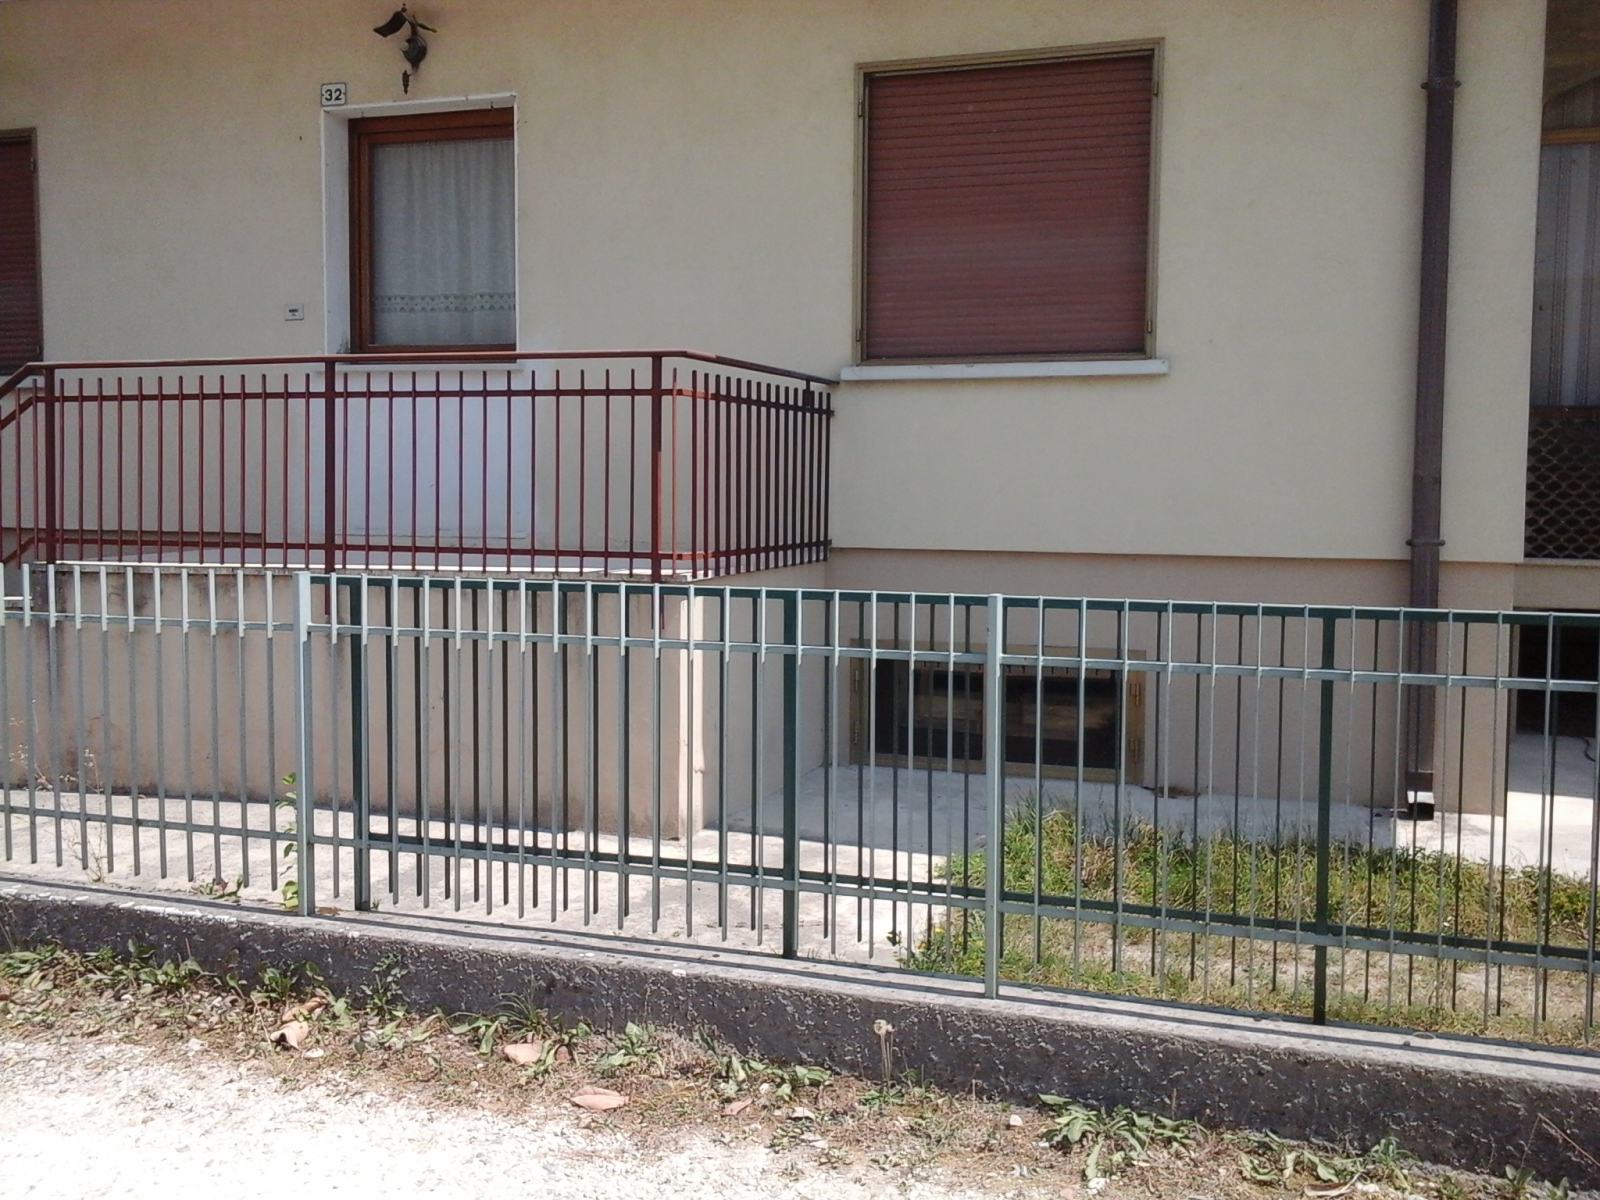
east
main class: Woodland
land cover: Broadleaved woodland
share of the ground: > 75 %
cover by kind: broadleaved forest trees 80 %, herbaceous plants 20 %
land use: Residential
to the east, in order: Broadleaved woodland; Artificial constructions in urban areas
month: July
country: IT
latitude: 45.8606
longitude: 12.1737
